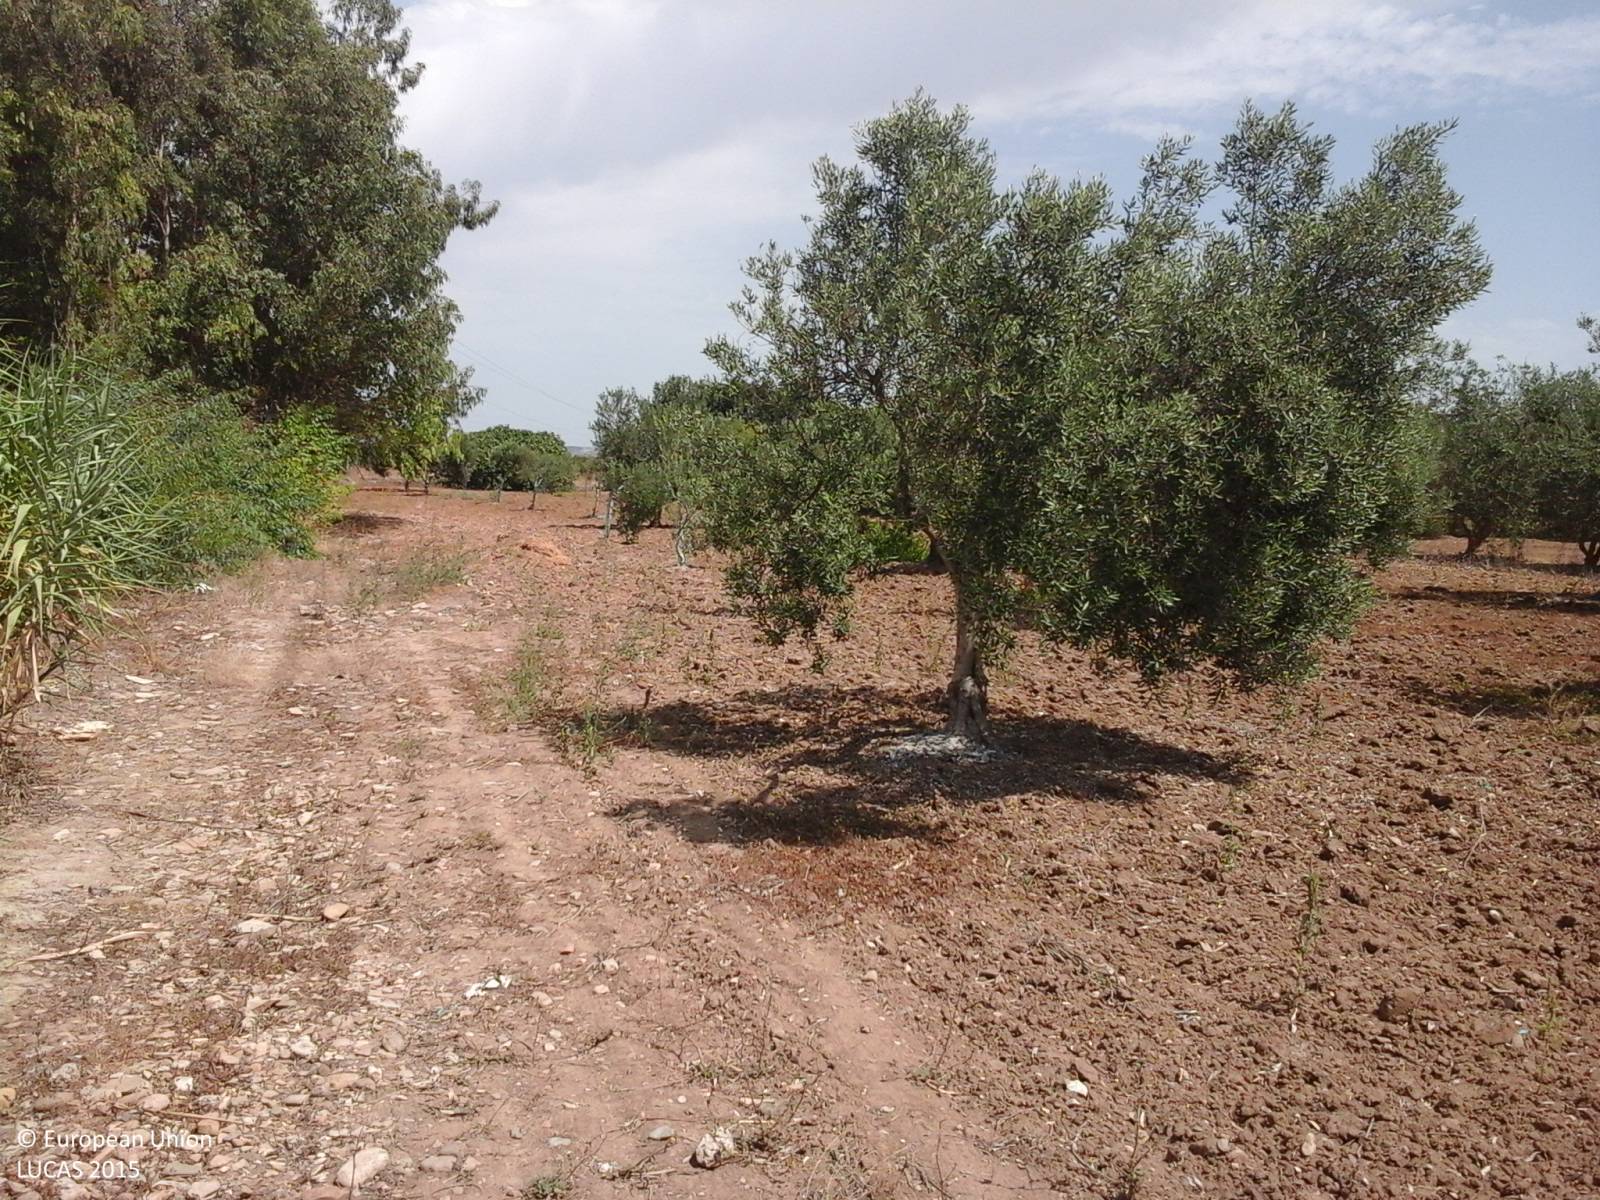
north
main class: Cropland
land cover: Olive groves
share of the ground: > 75 %
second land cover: Grassland without tree/shrub cover
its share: > 75 %
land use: Agriculture (excluding fallow land and kitchen gardens)
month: July
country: IT
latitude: 39.5005
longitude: 8.9018
